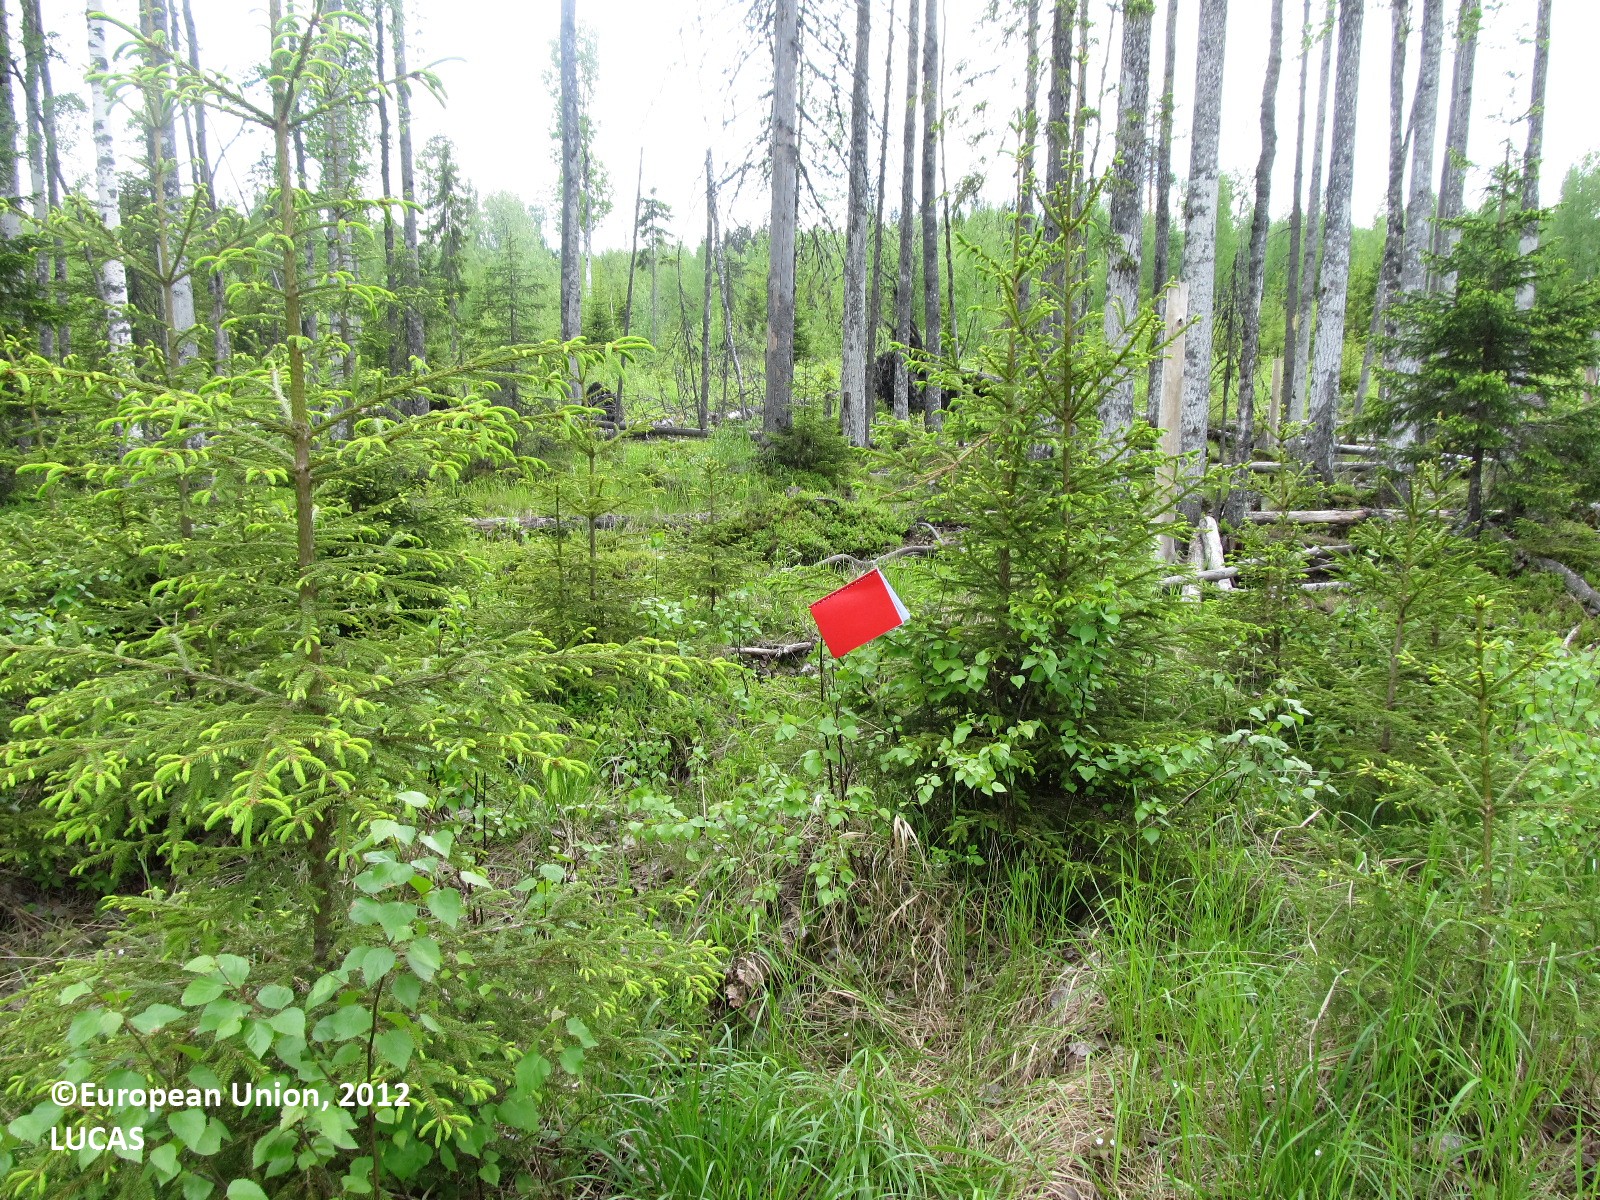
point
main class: Woodland
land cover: Spruce dominated coniferous woodland
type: boreal forest
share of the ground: 25 - 50 %
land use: Forestry
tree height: < 5 m
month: June
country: FI
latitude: 62.5795
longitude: 28.8402
